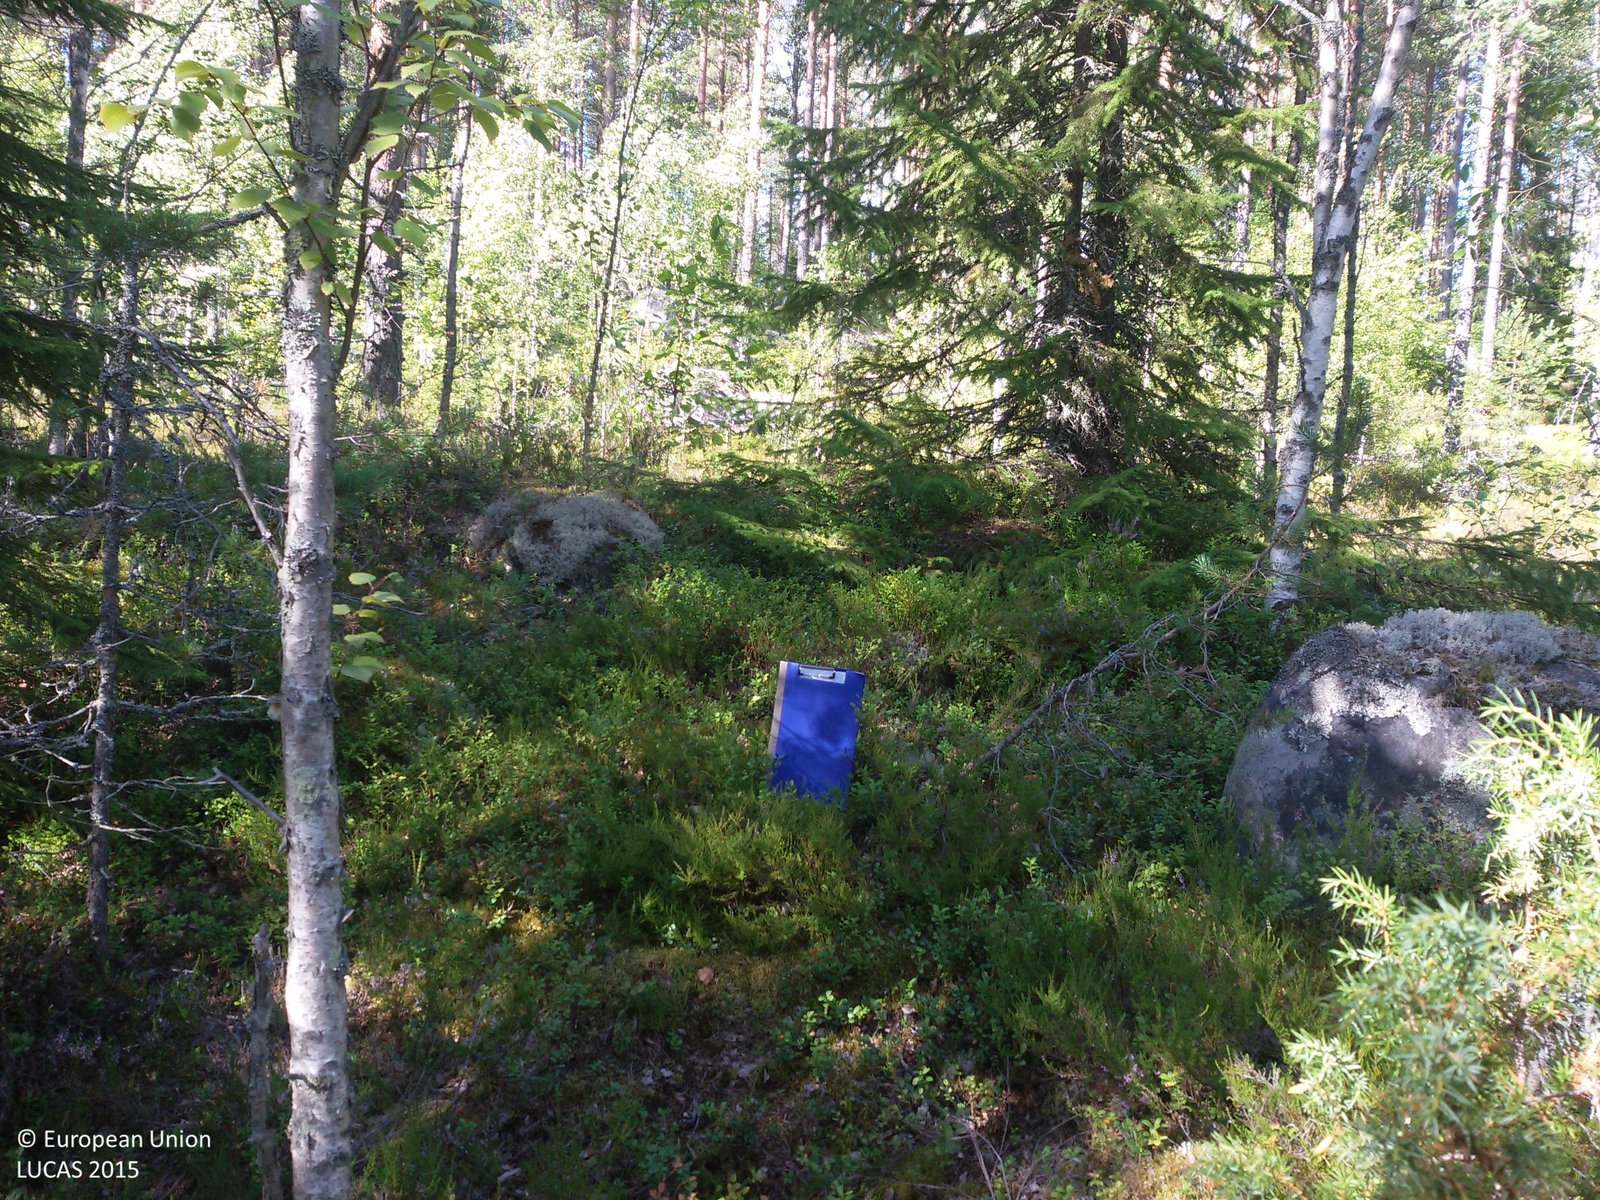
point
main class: Woodland
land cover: Other mixed woodland
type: boreal forest
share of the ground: 50 - 75 %
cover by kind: coniferous forest trees 50 %, broadleaved forest trees 25 %, shrubs 15 %, herbaceous plants 5 %, lichens and mosses 5 %
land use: Forestry
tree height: > 5 m
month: August
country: SE
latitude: 60.9598
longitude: 15.9141
